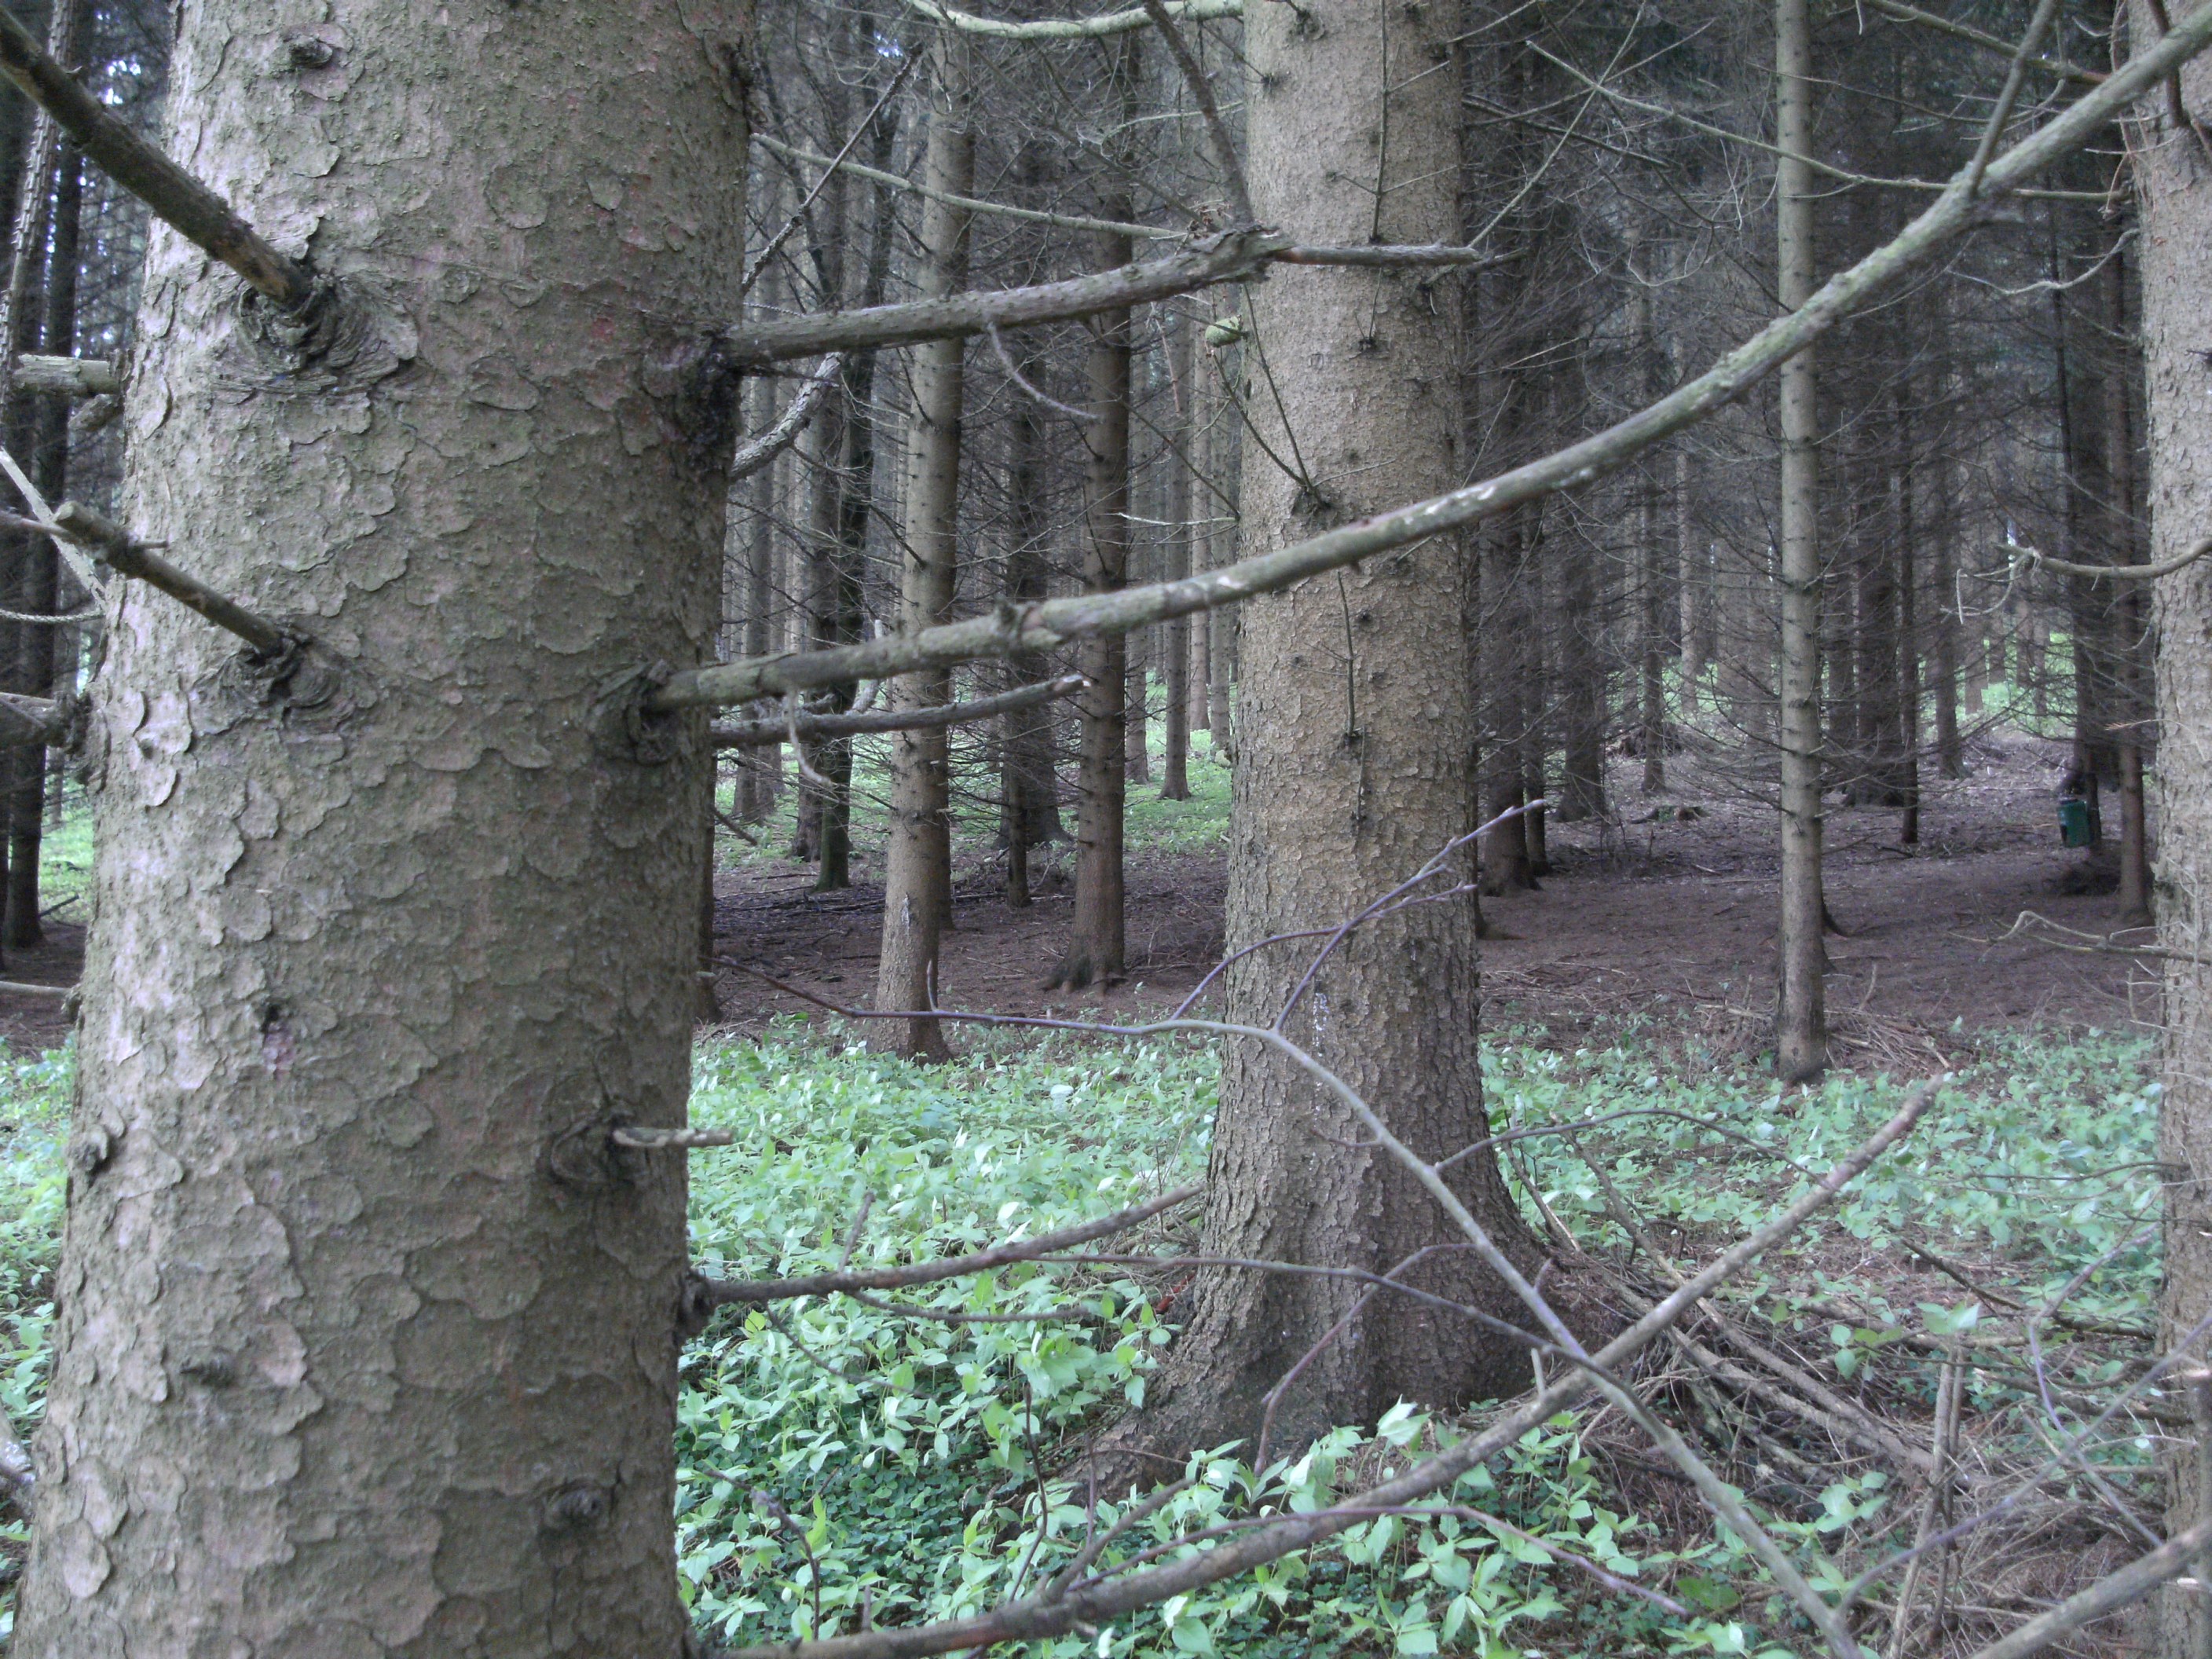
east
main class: Woodland
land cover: Spruce dominated coniferous woodland
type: hemiboreal forest and nemoral coniferous forest and mixed broadleaved-coniferous forest
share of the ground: > 75 %
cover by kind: coniferous forest trees 80 %, herbaceous plants 20 %
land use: Forestry
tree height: > 5 m
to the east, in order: Spruce dominated coniferous woodland; Tracks; Spruce dominated coniferous woodland
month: June
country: AT
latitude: 48.5174
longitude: 14.3192
